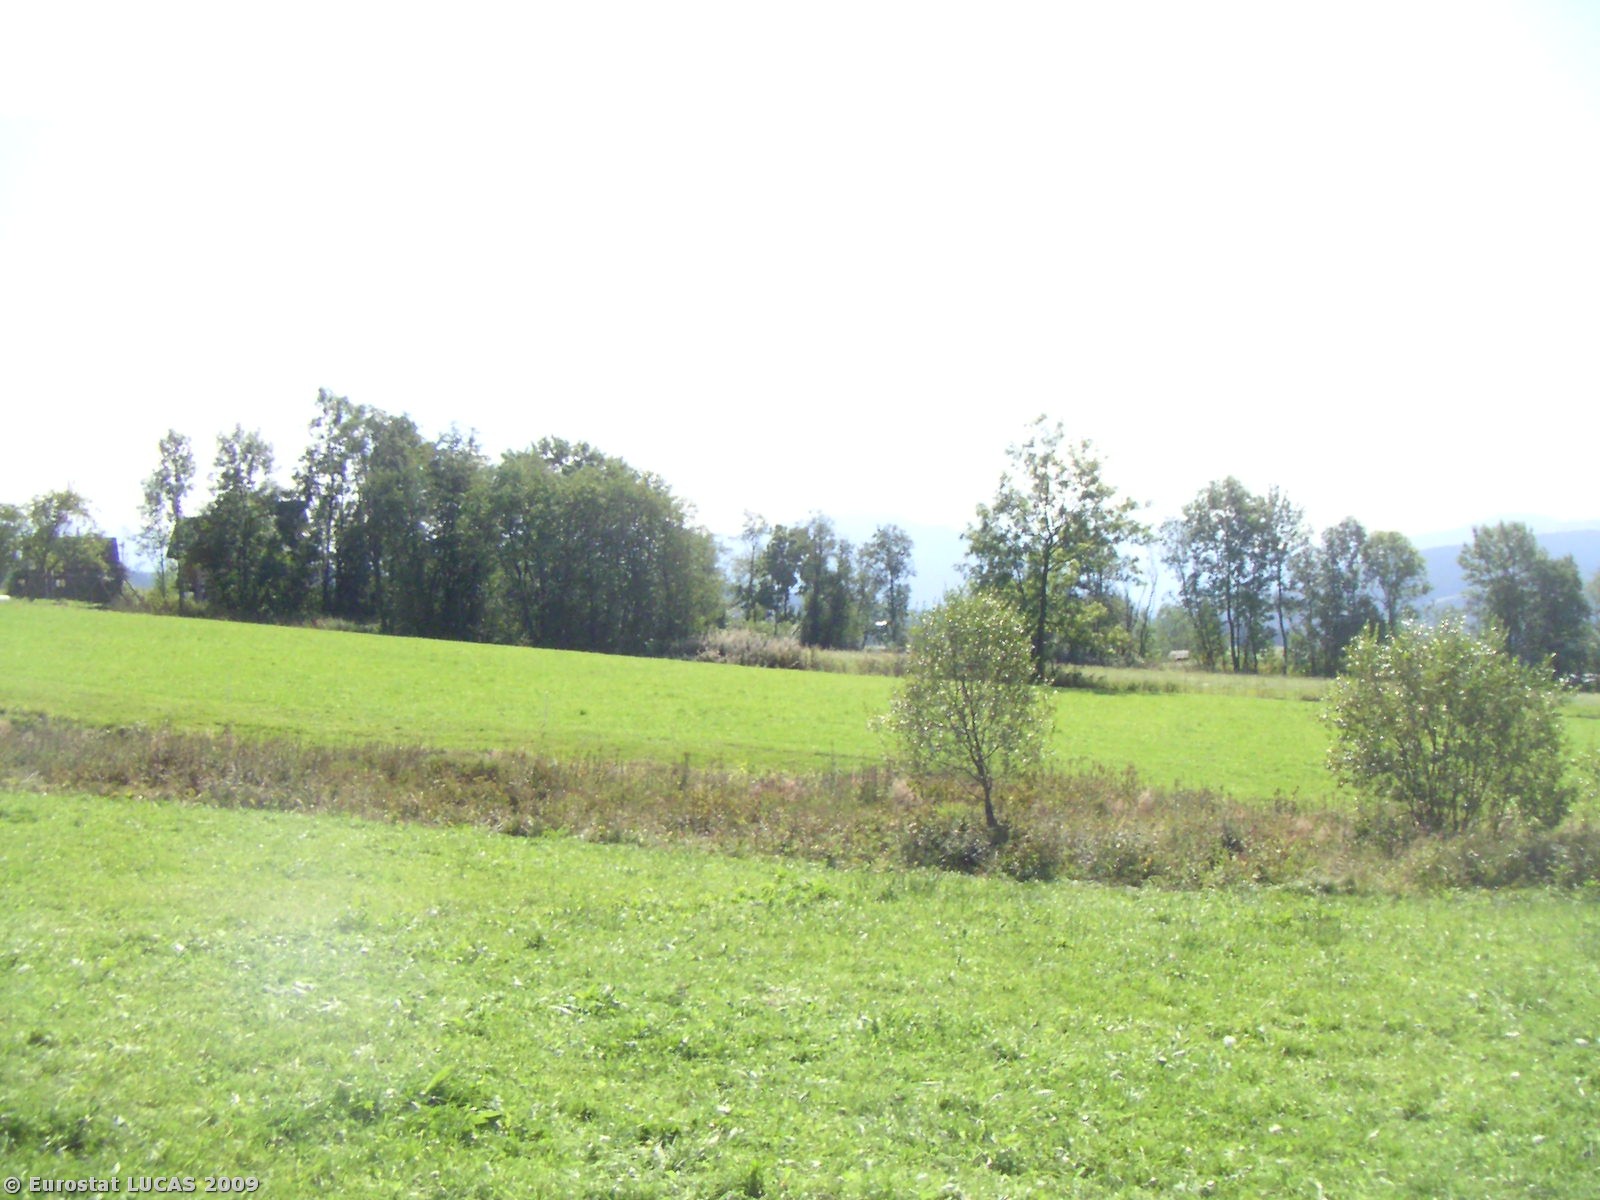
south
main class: Grassland
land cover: Grassland without tree/shrub cover
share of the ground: > 75 %
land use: Agriculture (excluding fallow land and kitchen gardens)
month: September
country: PL
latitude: 49.3406
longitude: 19.8429
